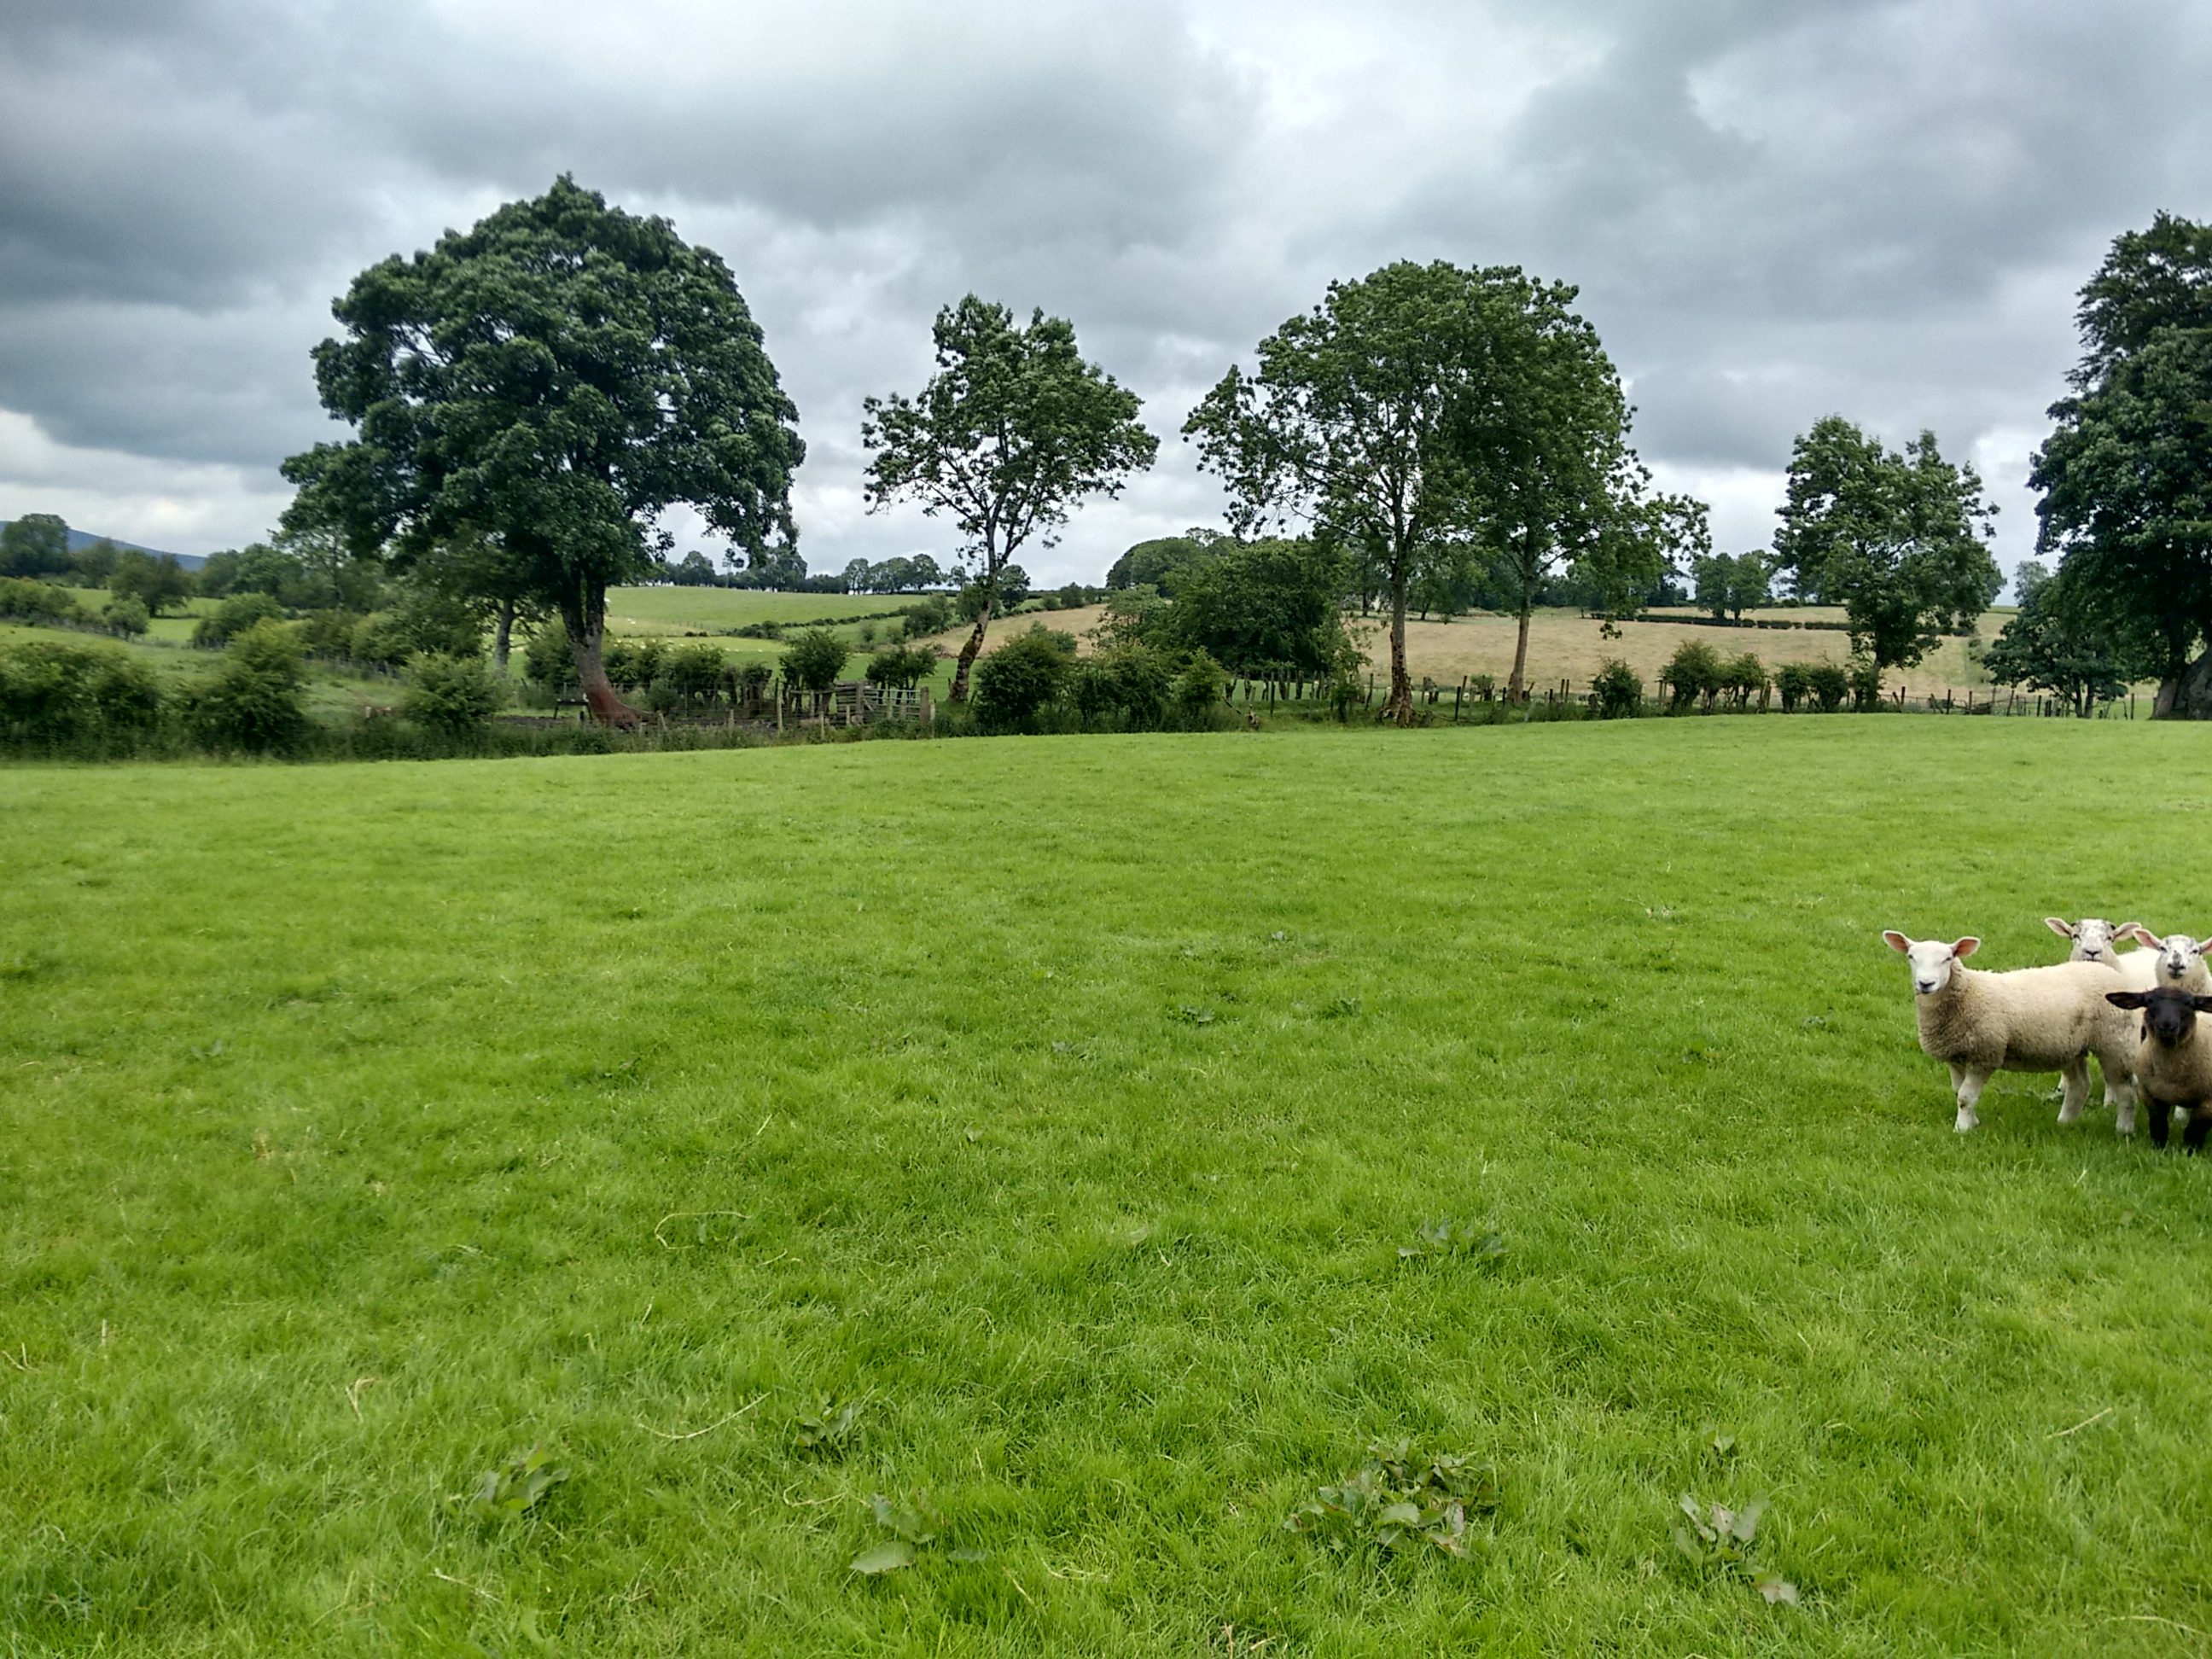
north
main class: Grassland
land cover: Grassland without tree/shrub cover
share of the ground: > 75 %
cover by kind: herbaceous plants 100 %
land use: Agriculture (excluding fallow land and kitchen gardens)
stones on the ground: 10 - 25 %
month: July
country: GB
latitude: 54.5952
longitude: -7.1538
